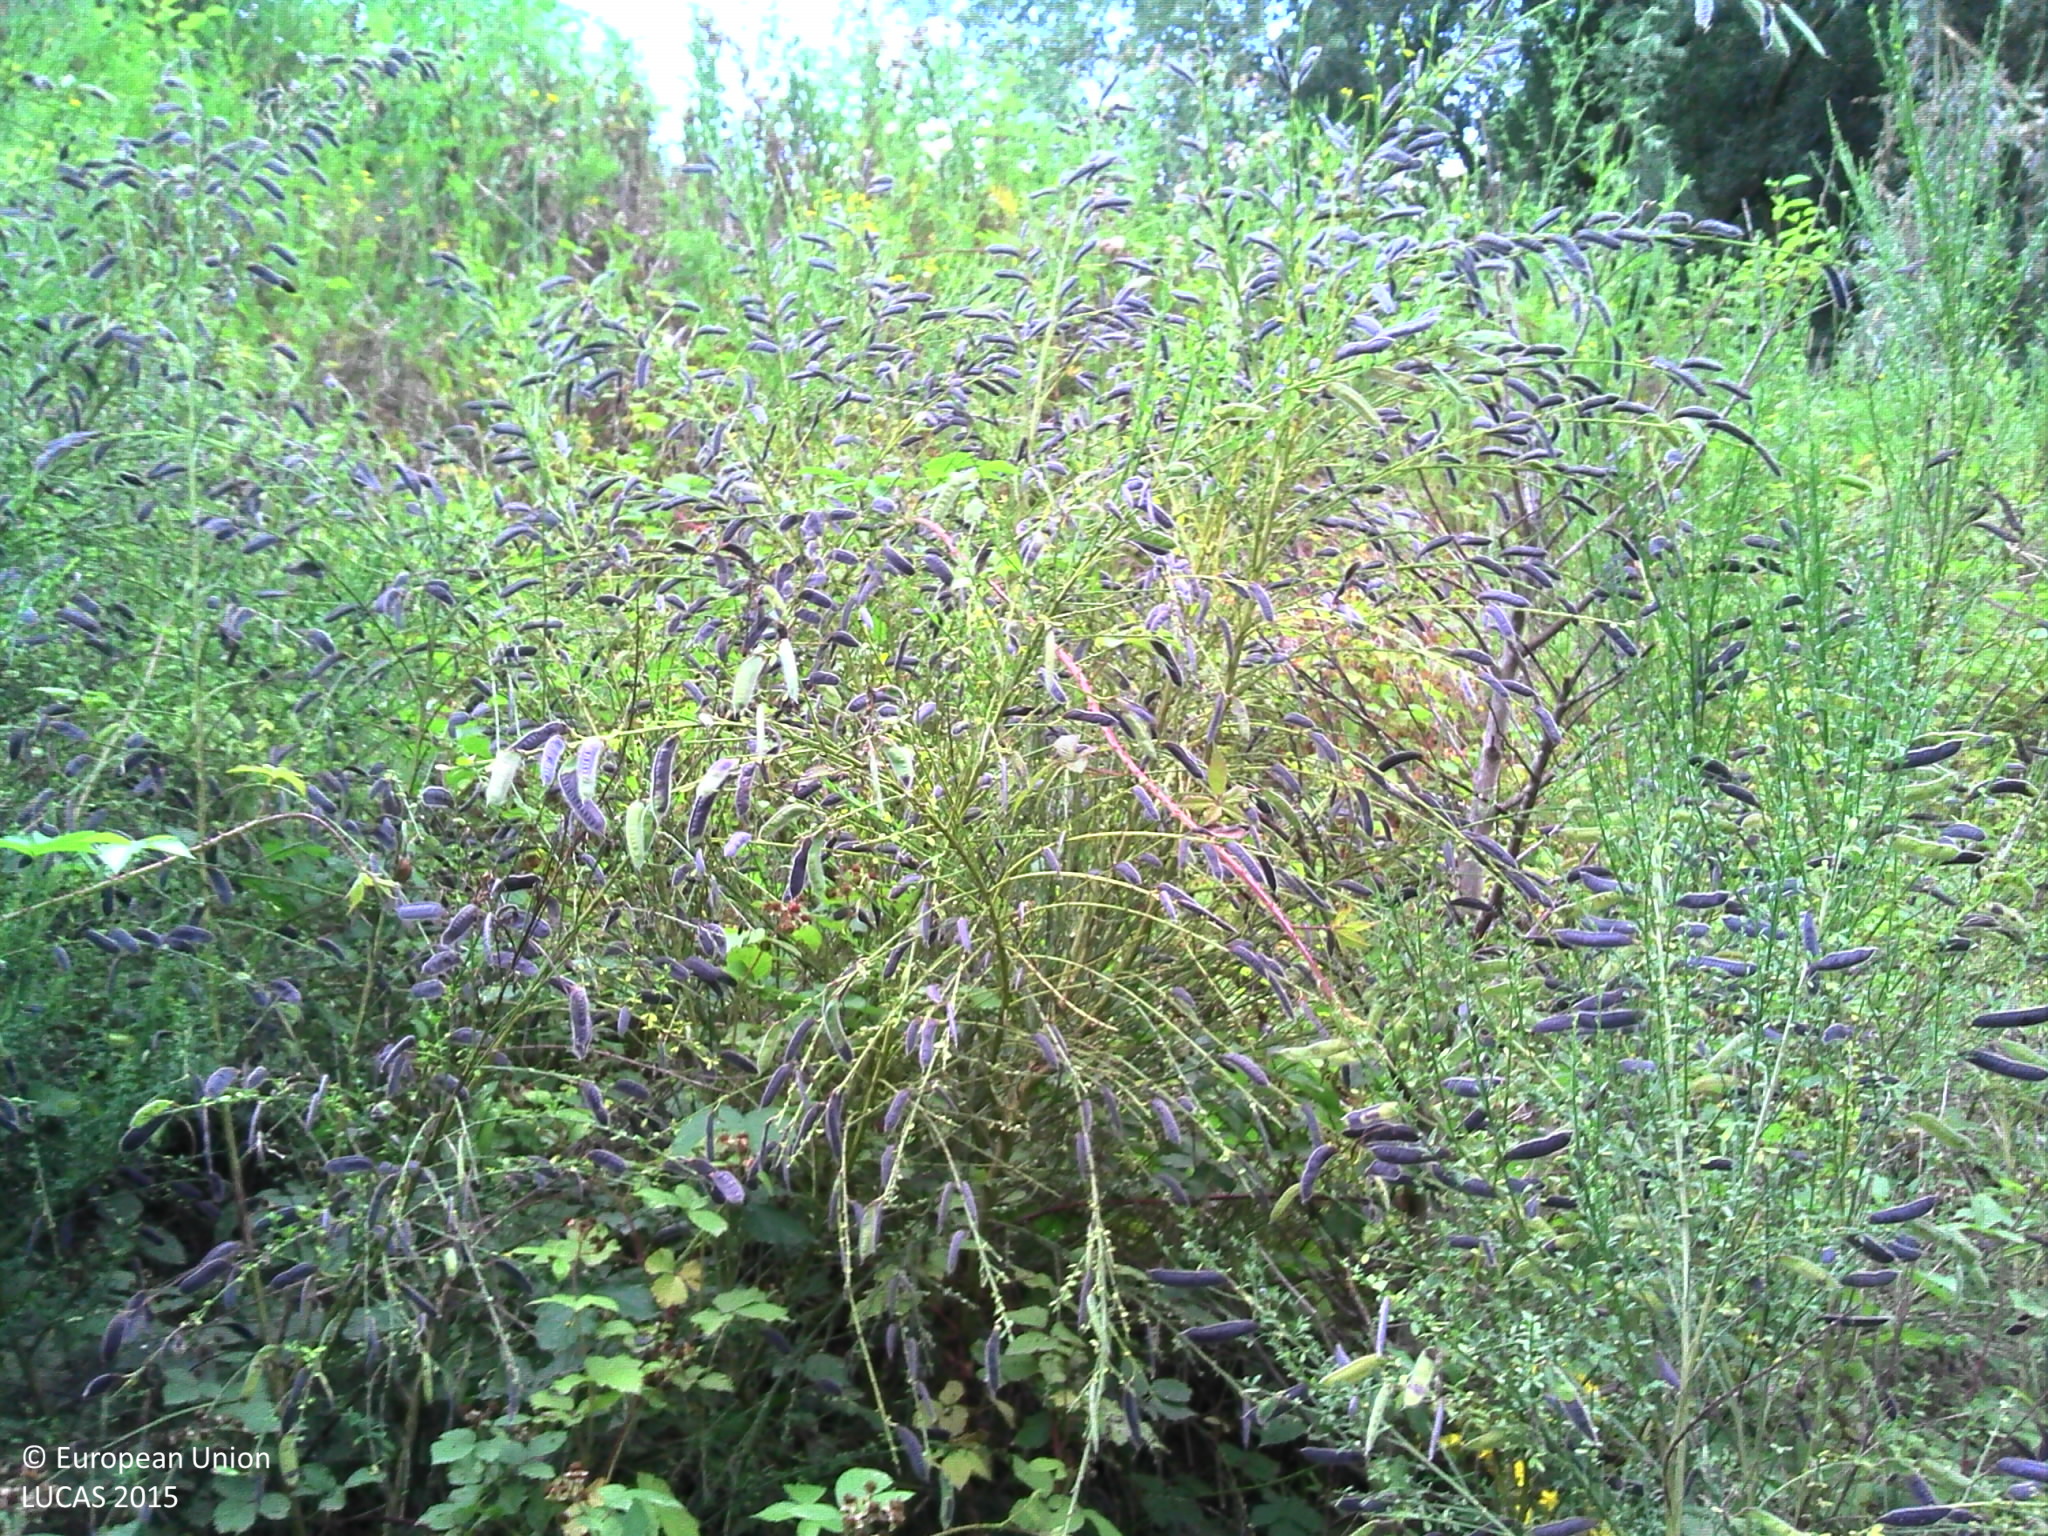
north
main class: Woodland
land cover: Broadleaved woodland
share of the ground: > 75 %
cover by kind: broadleaved forest trees 70 %, herbaceous plants 30 %
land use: Semi-natural and natural areas not in use
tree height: > 5 m
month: July
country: BE
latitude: 50.5591
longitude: 4.5613
